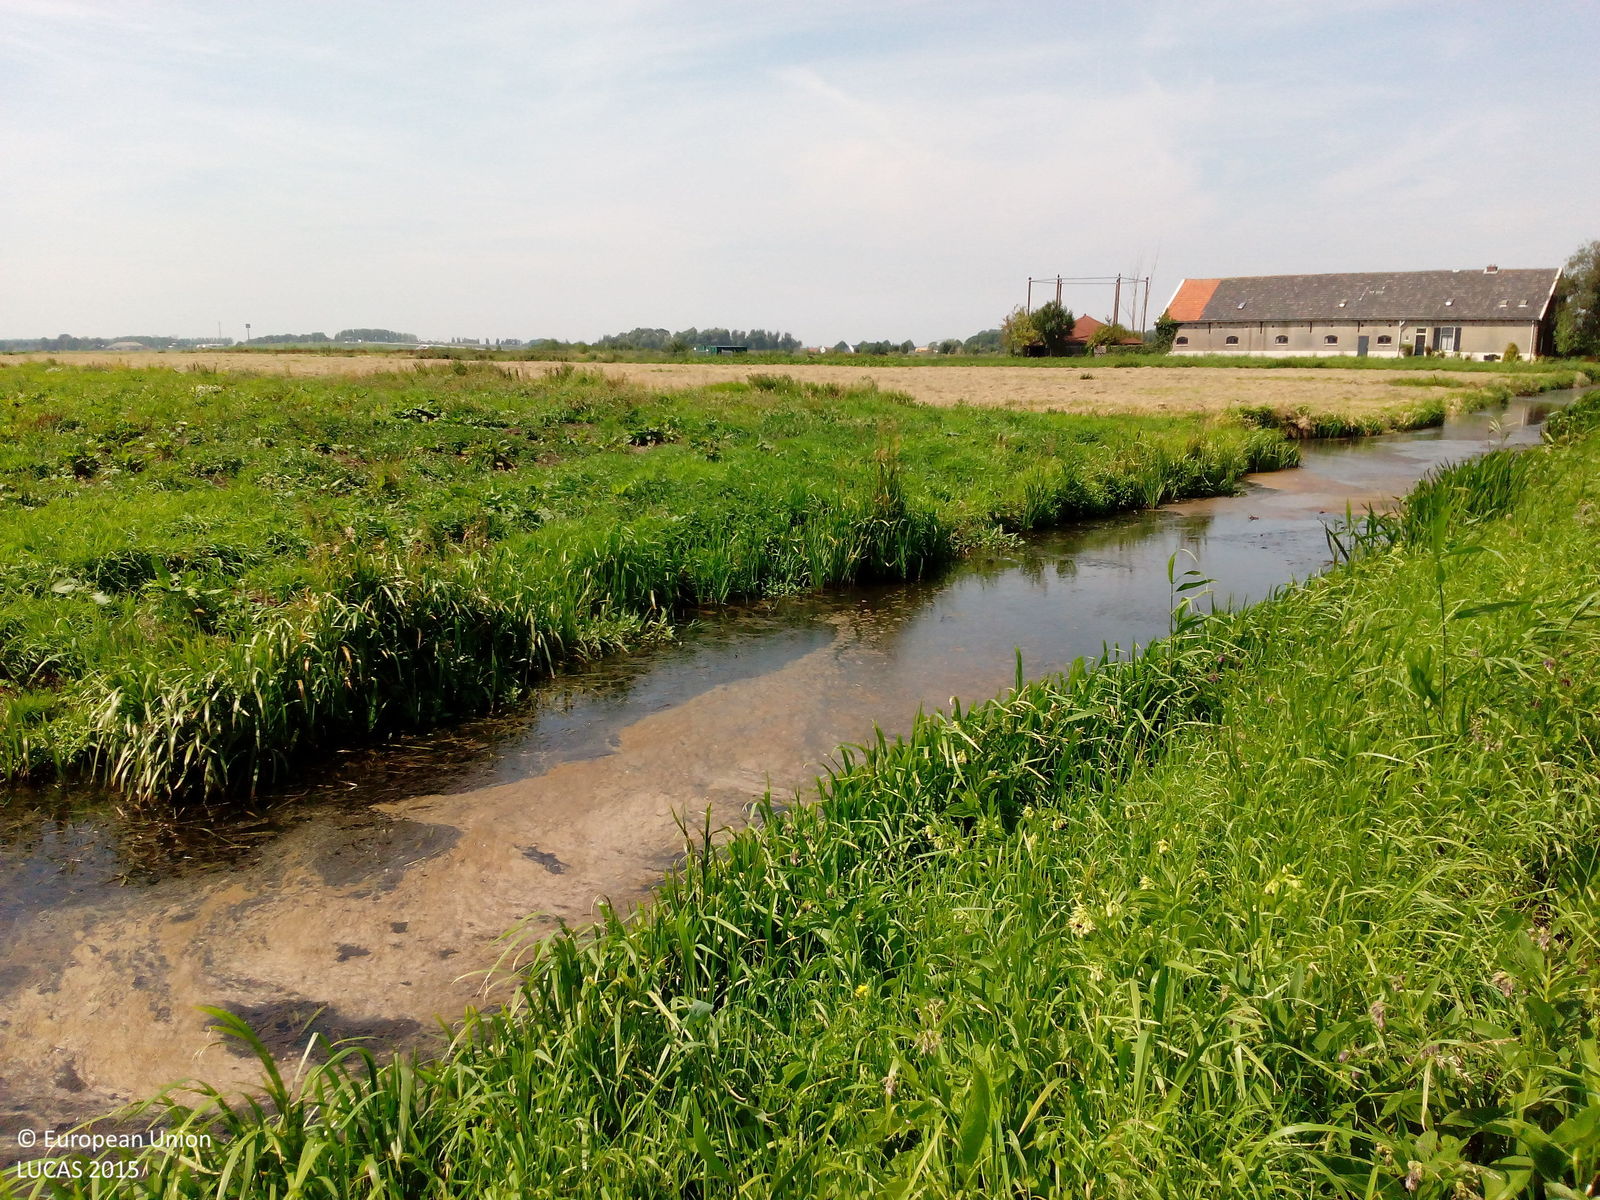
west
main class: Grassland
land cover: Grassland without tree/shrub cover
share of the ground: > 75 %
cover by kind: herbaceous plants 80 %, unconsolidated bare surface 20 %
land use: Agriculture (excluding fallow land and kitchen gardens)
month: August
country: NL
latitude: 52.0060
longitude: 4.6792
